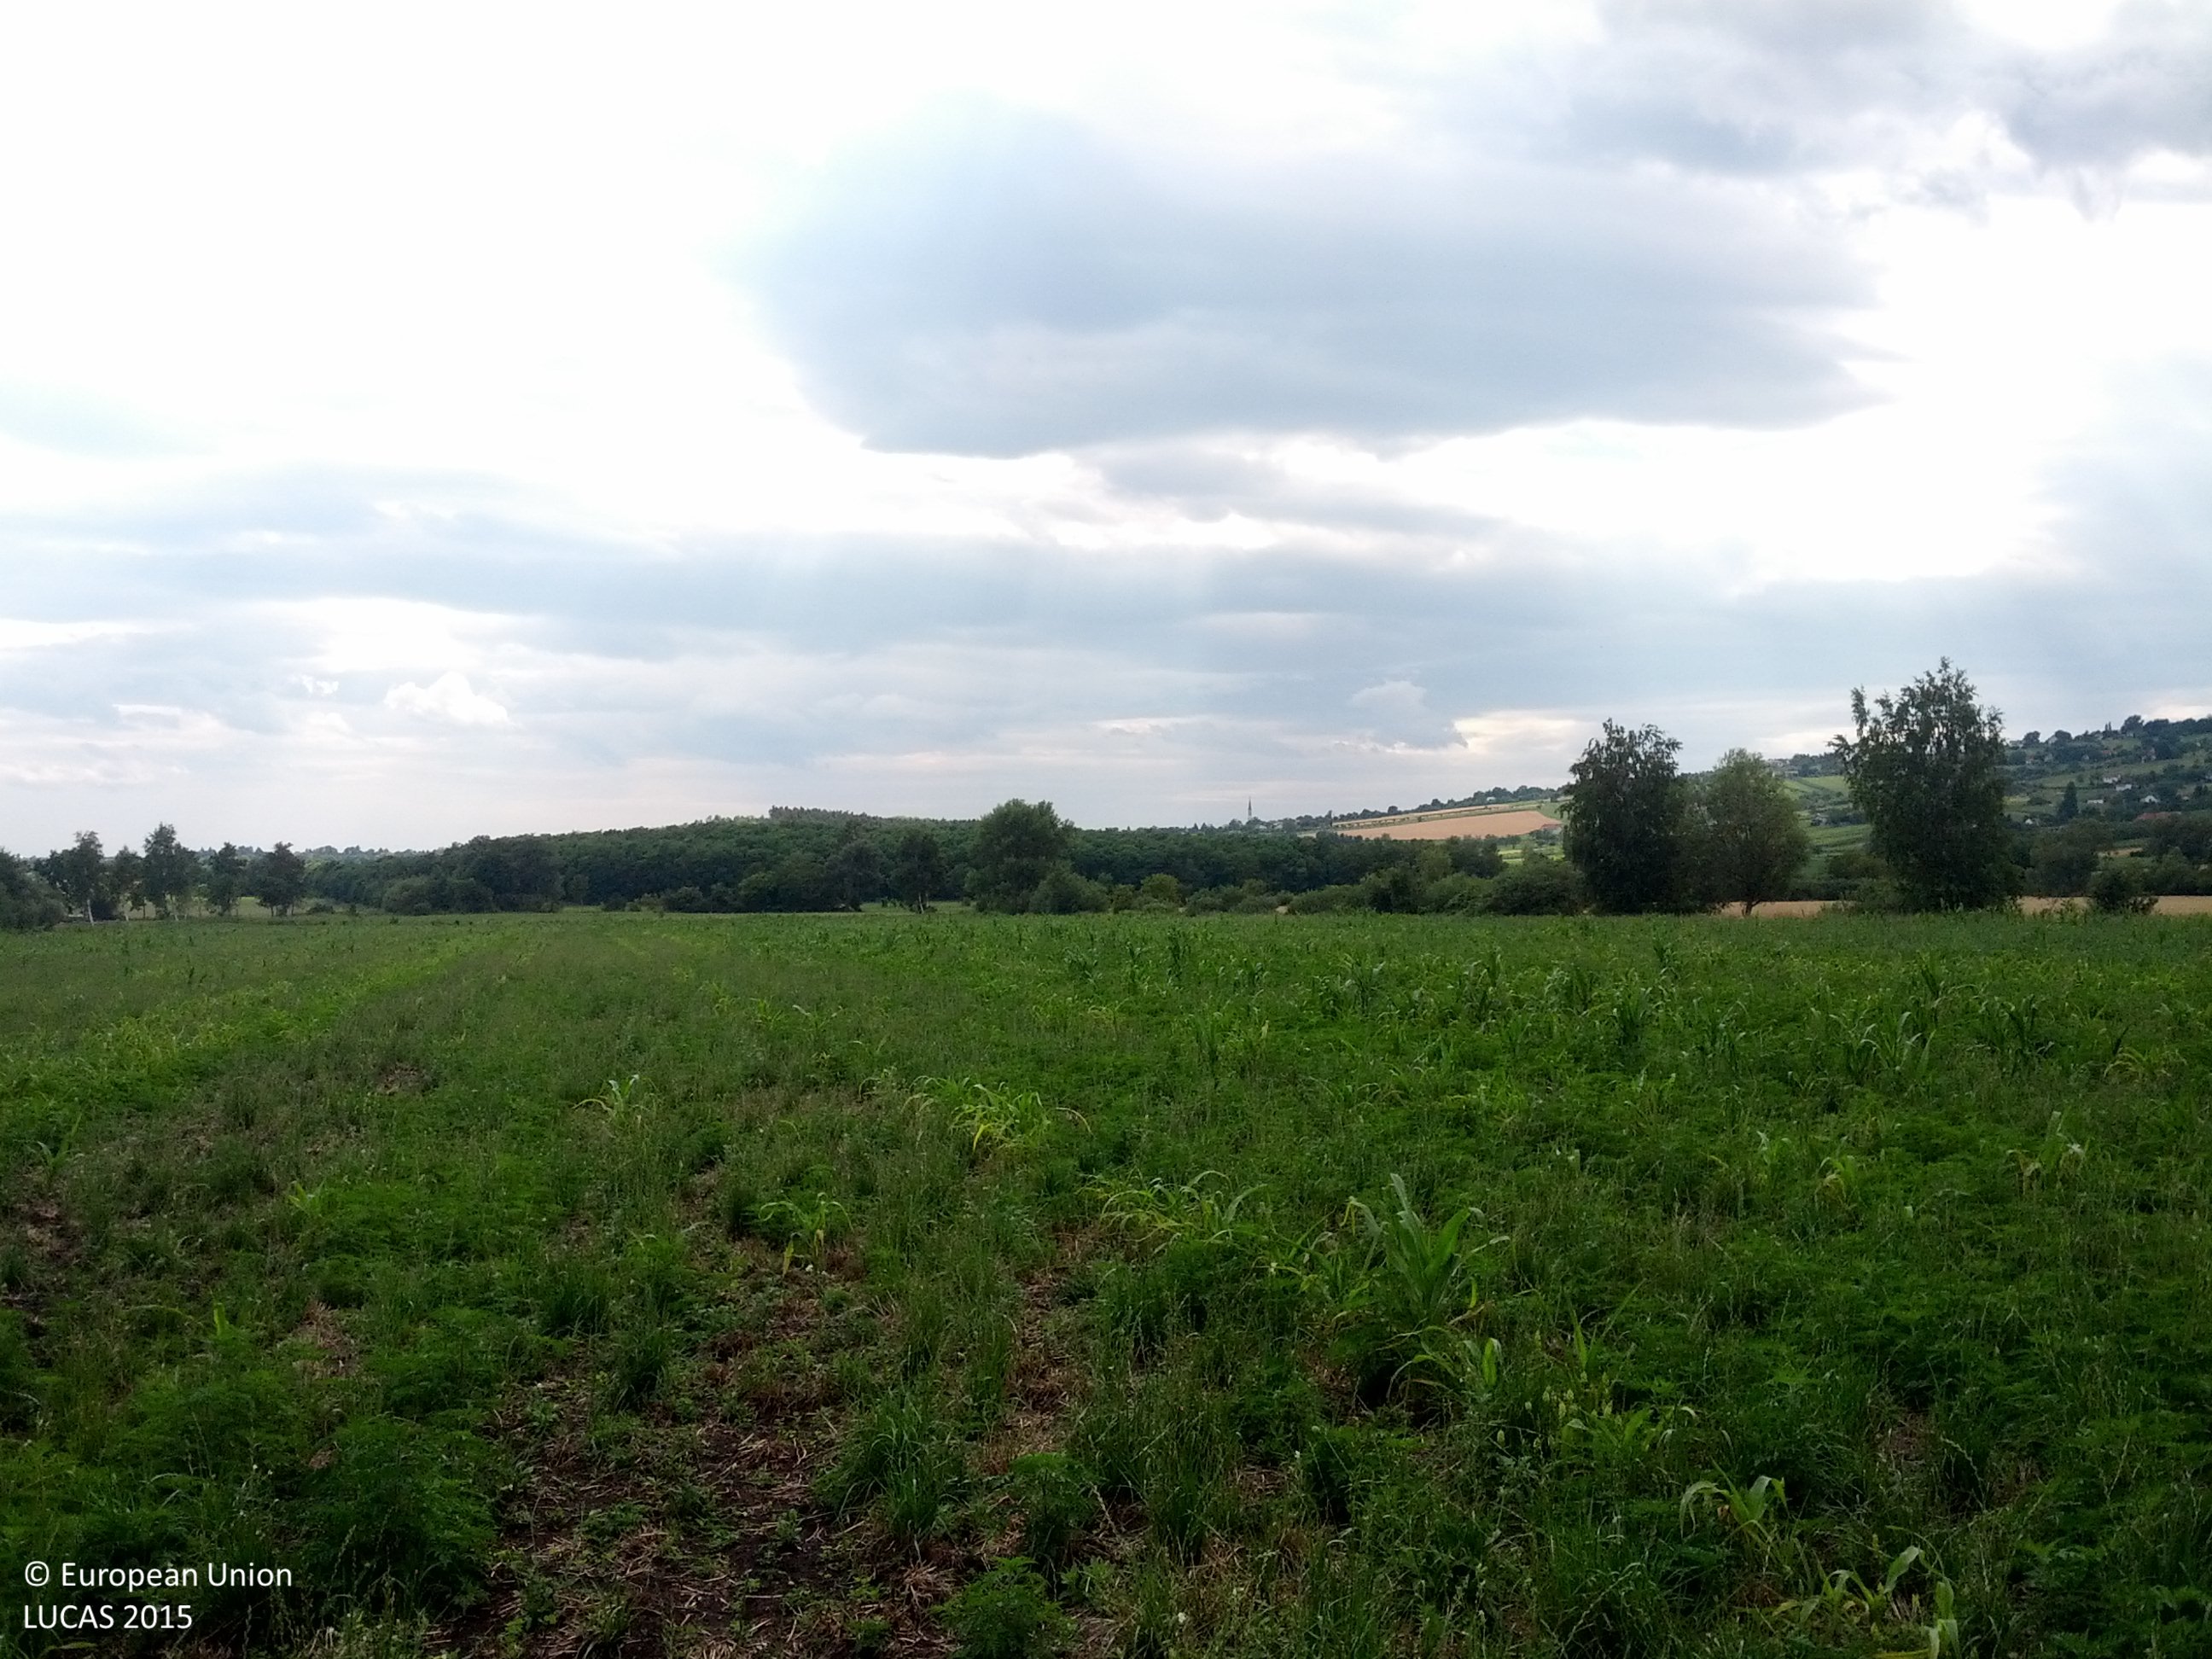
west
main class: Cropland
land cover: Temporary grasslands
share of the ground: > 75 %
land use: Agriculture (excluding fallow land and kitchen gardens)
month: July
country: AT
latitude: 47.3112
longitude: 16.4717
